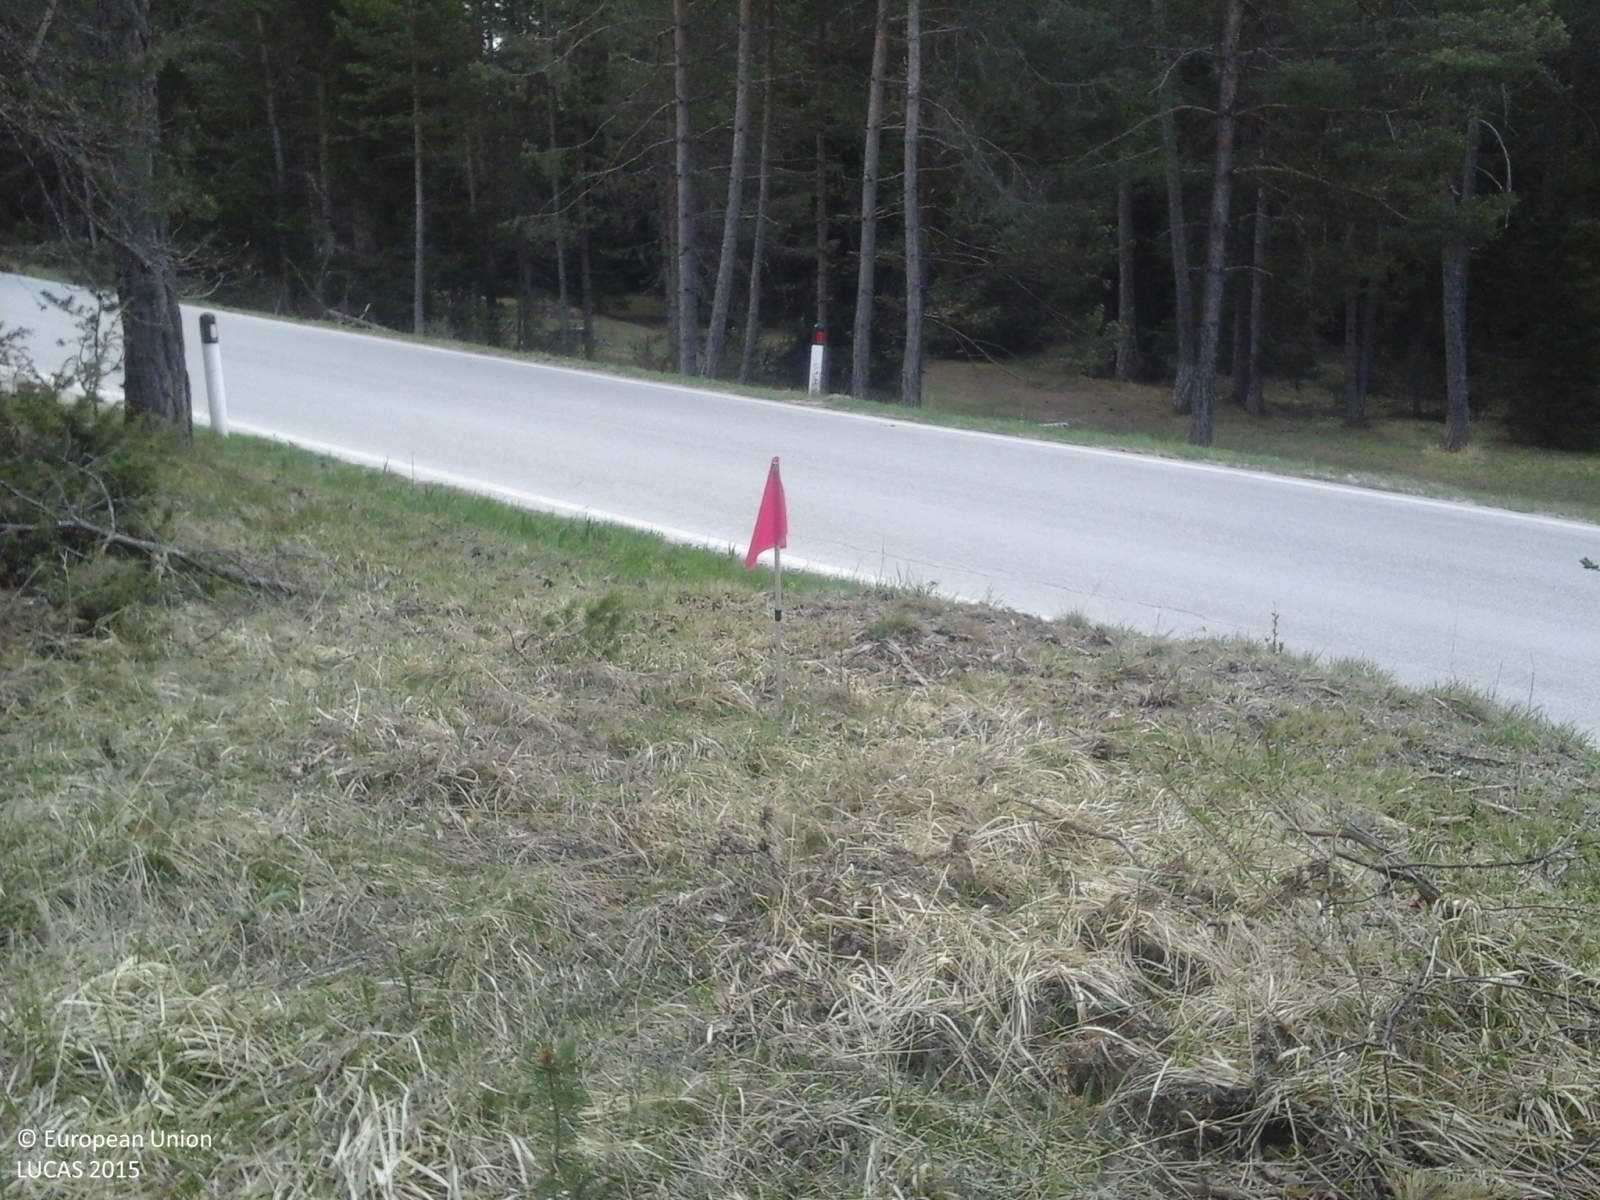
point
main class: Woodland
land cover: Pine dominated coniferous woodland
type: alpine coniferous forest
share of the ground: 50 - 75 %
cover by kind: coniferous forest trees 60 %, herbaceous plants 35 %, shrubs 5 %
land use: Forestry
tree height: > 5 m
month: April
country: IT
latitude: 46.3452
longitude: 11.1290
